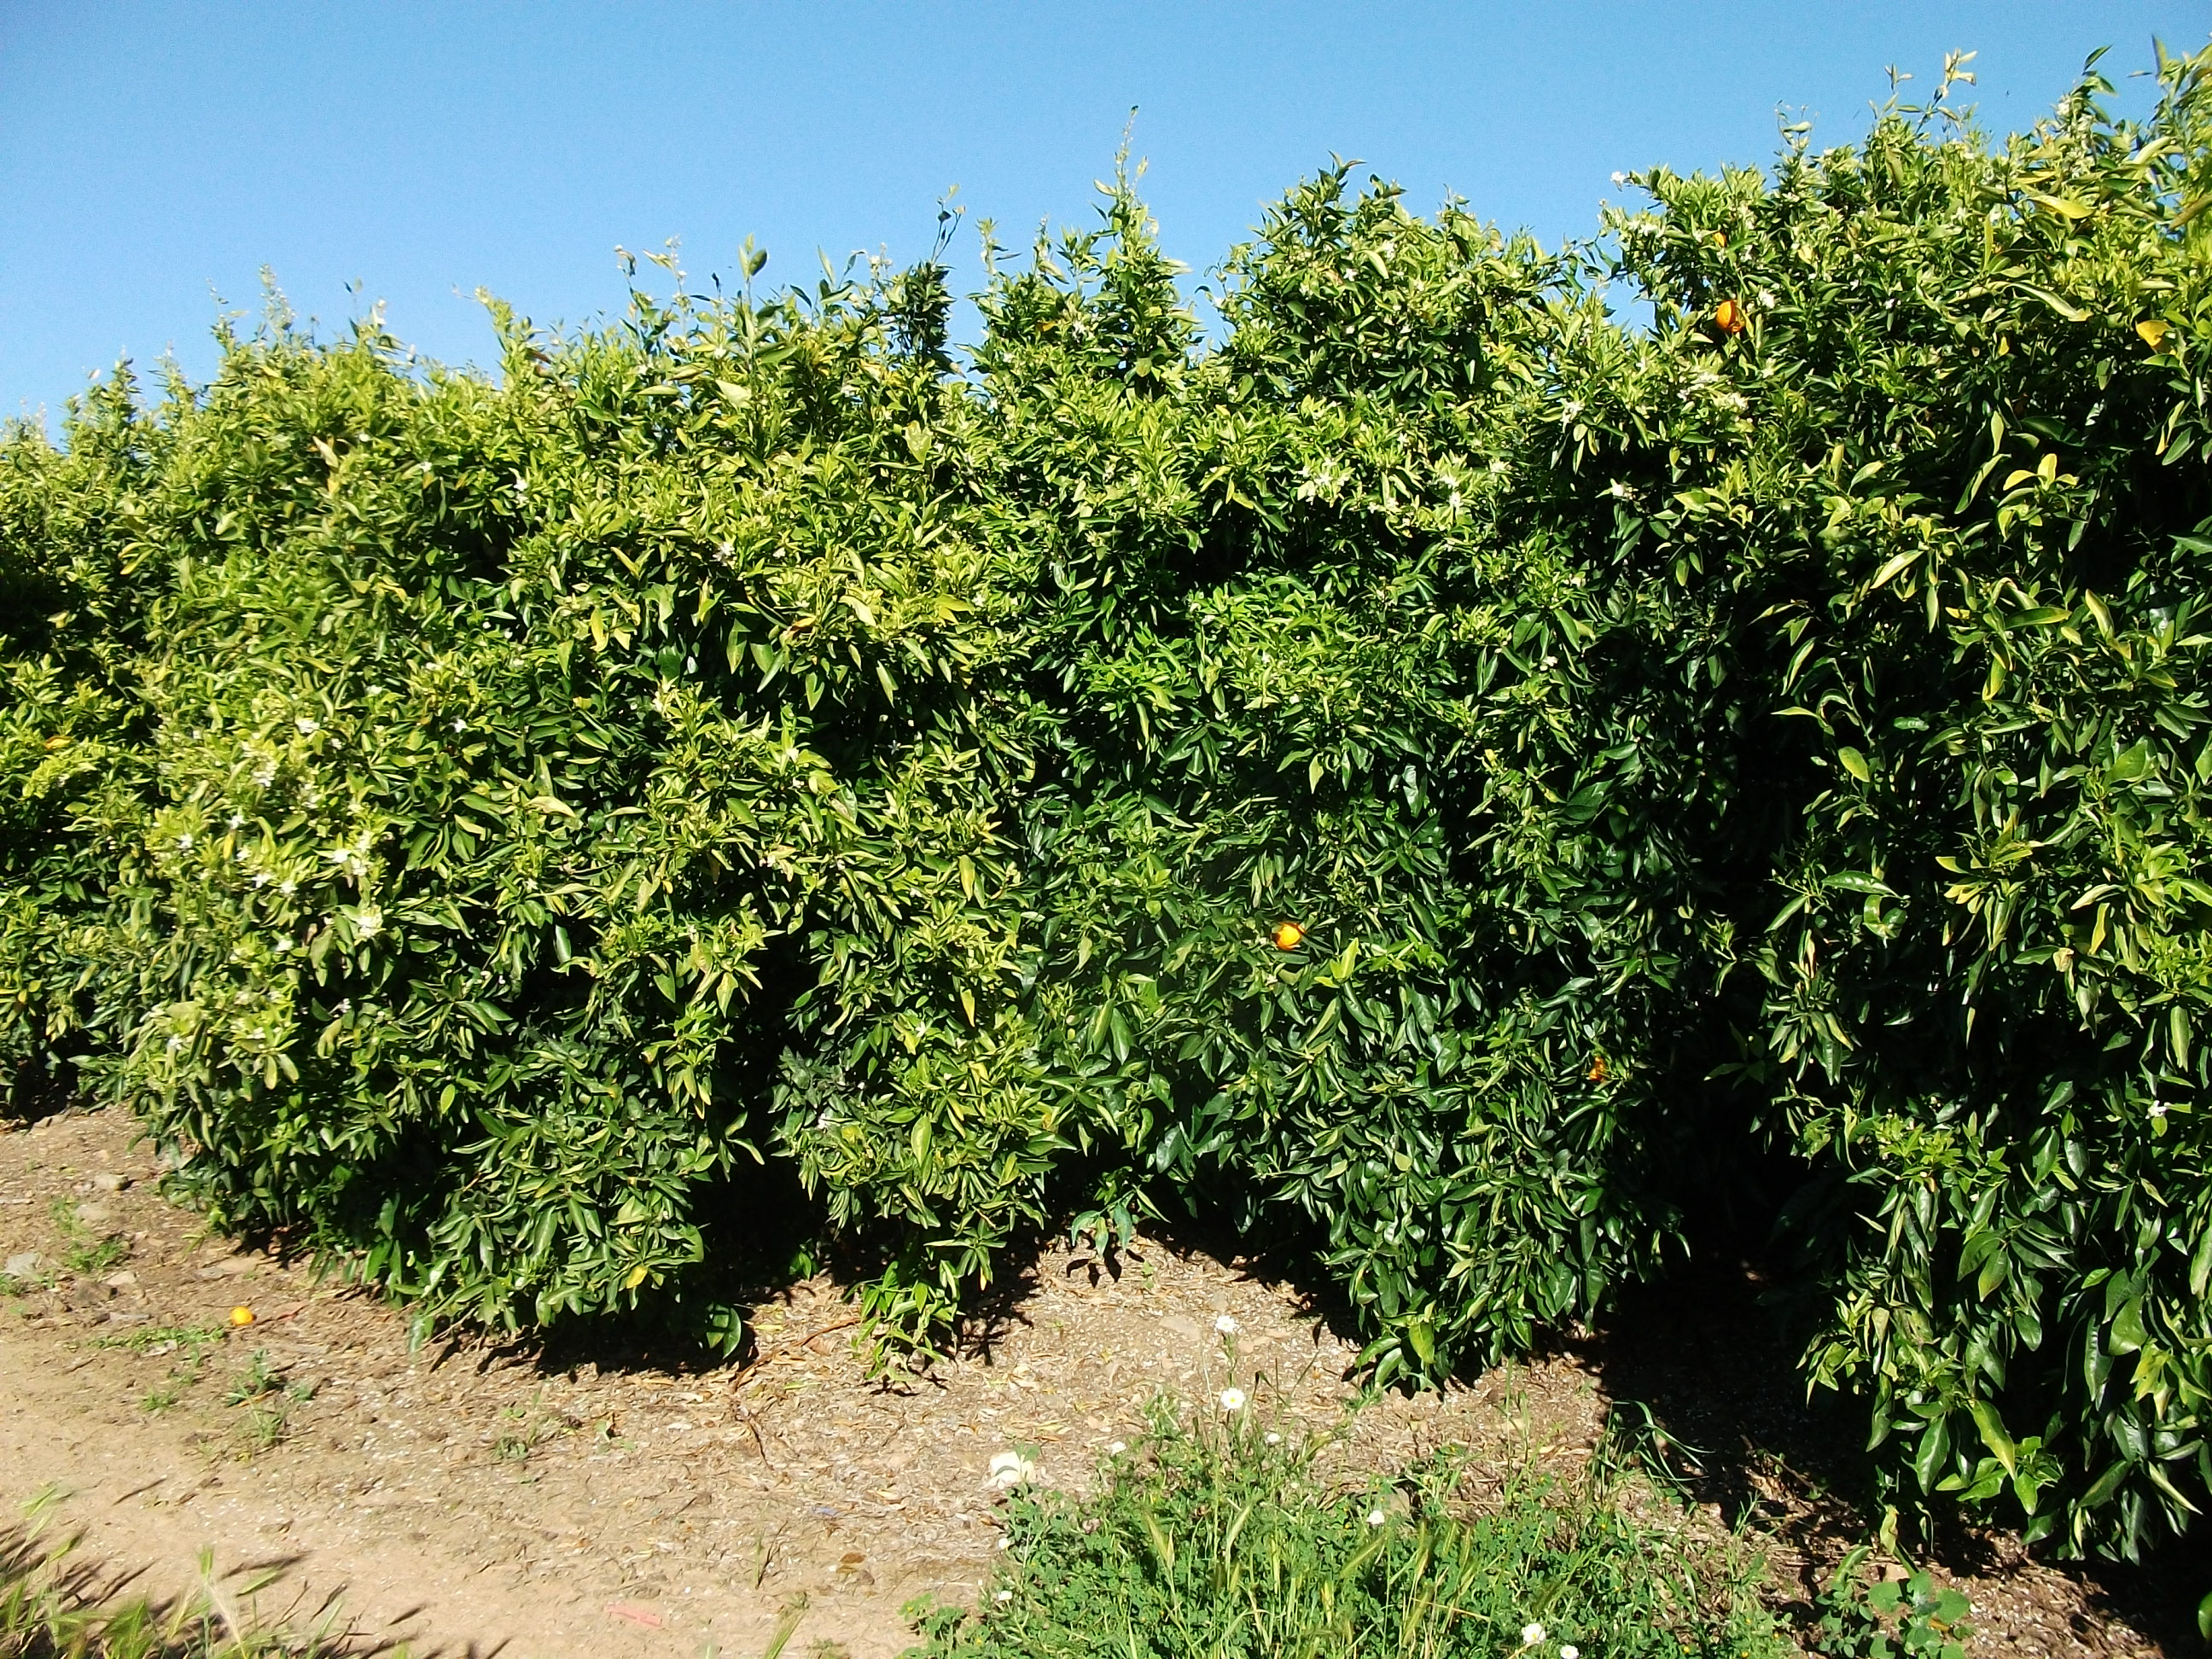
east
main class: Shrubland
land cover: Shrubland without tree cover
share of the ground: > 75 %
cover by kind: shrubs 100 %
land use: Semi-natural and natural areas not in use
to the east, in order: Shrubland without tree cover; Rivers and streams; Grass margins; Tracks; Oranges; Tracks; Shrubland without tree cover; Tracks; Oranges; Tracks; Oranges; Shrubland without tree cover; Oranges; Shrubland without tree cover; Oranges
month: April
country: ES
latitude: 37.6616
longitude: -6.6016
